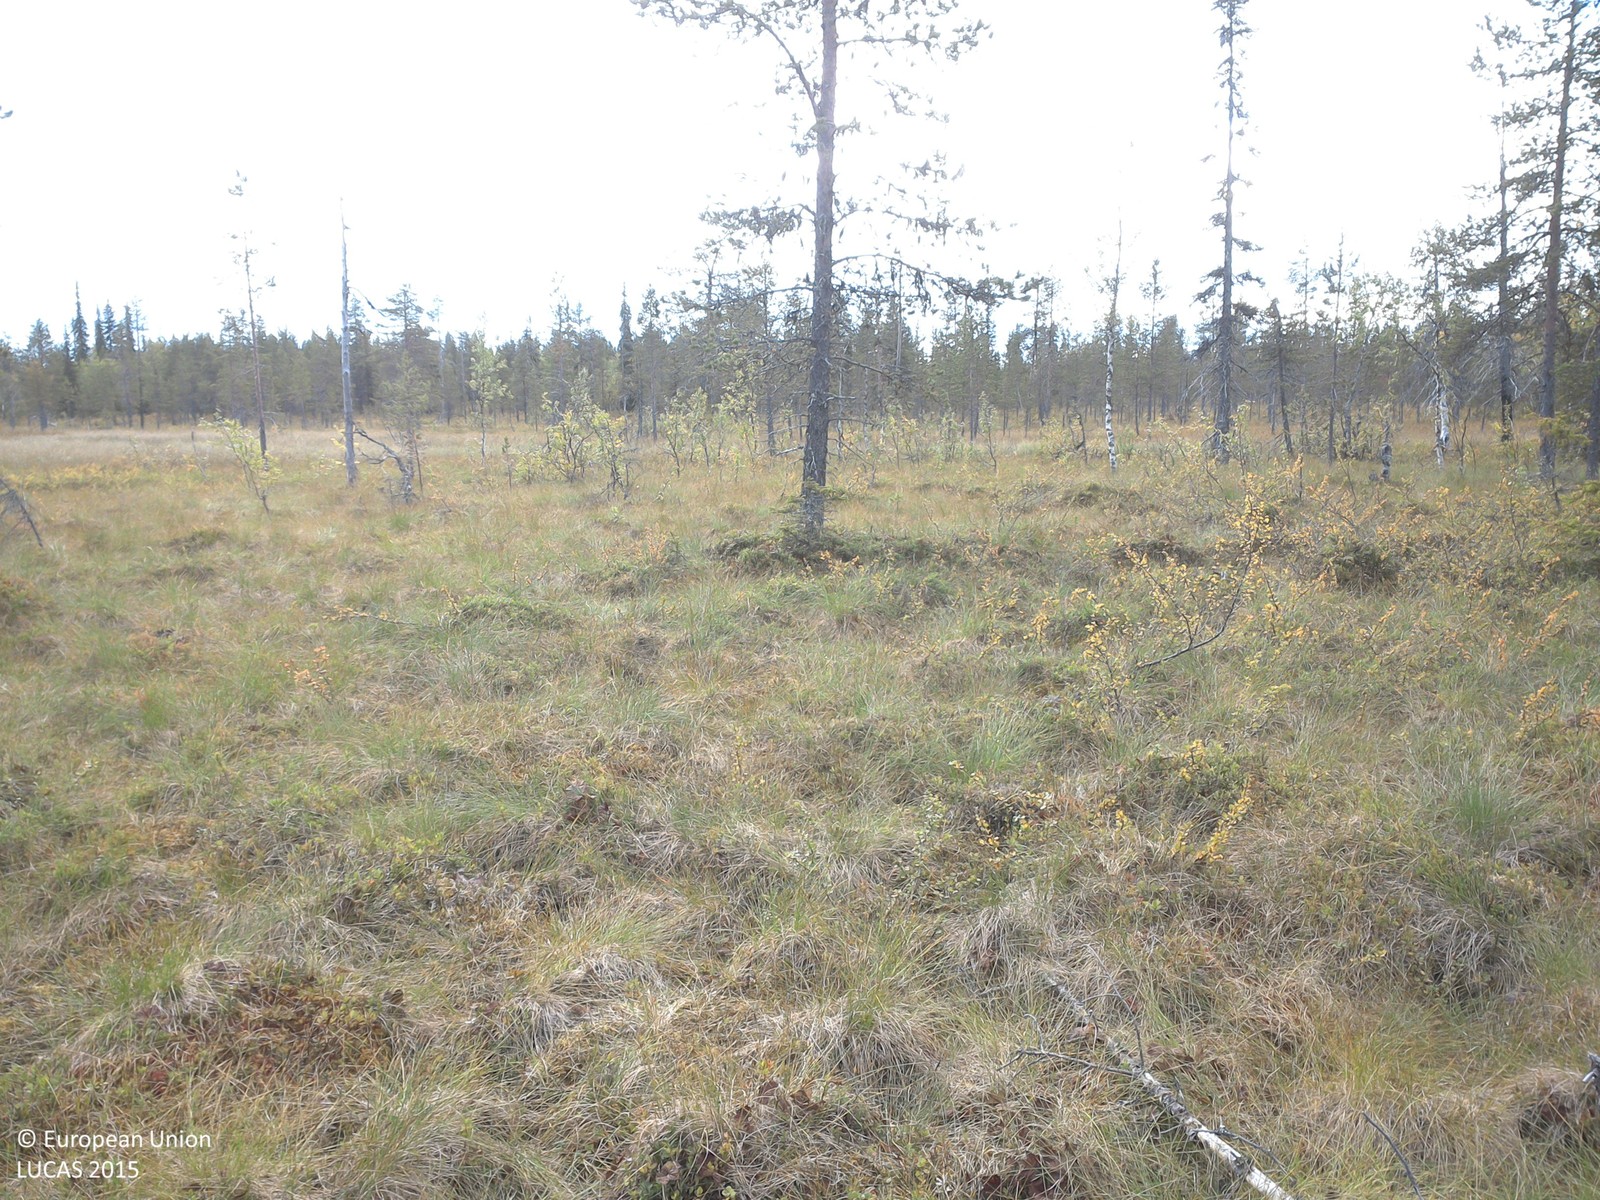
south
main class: Woodland
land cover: Pine dominated coniferous woodland
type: boreal forest
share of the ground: 10 - 25 %
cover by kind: shrubs 60 %, coniferous forest trees 15 %, lichens and mosses 15 %, herbaceous plants 10 %
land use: Forestry
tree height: > 5 m
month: September
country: SE
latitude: 67.8627
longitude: 23.1091
